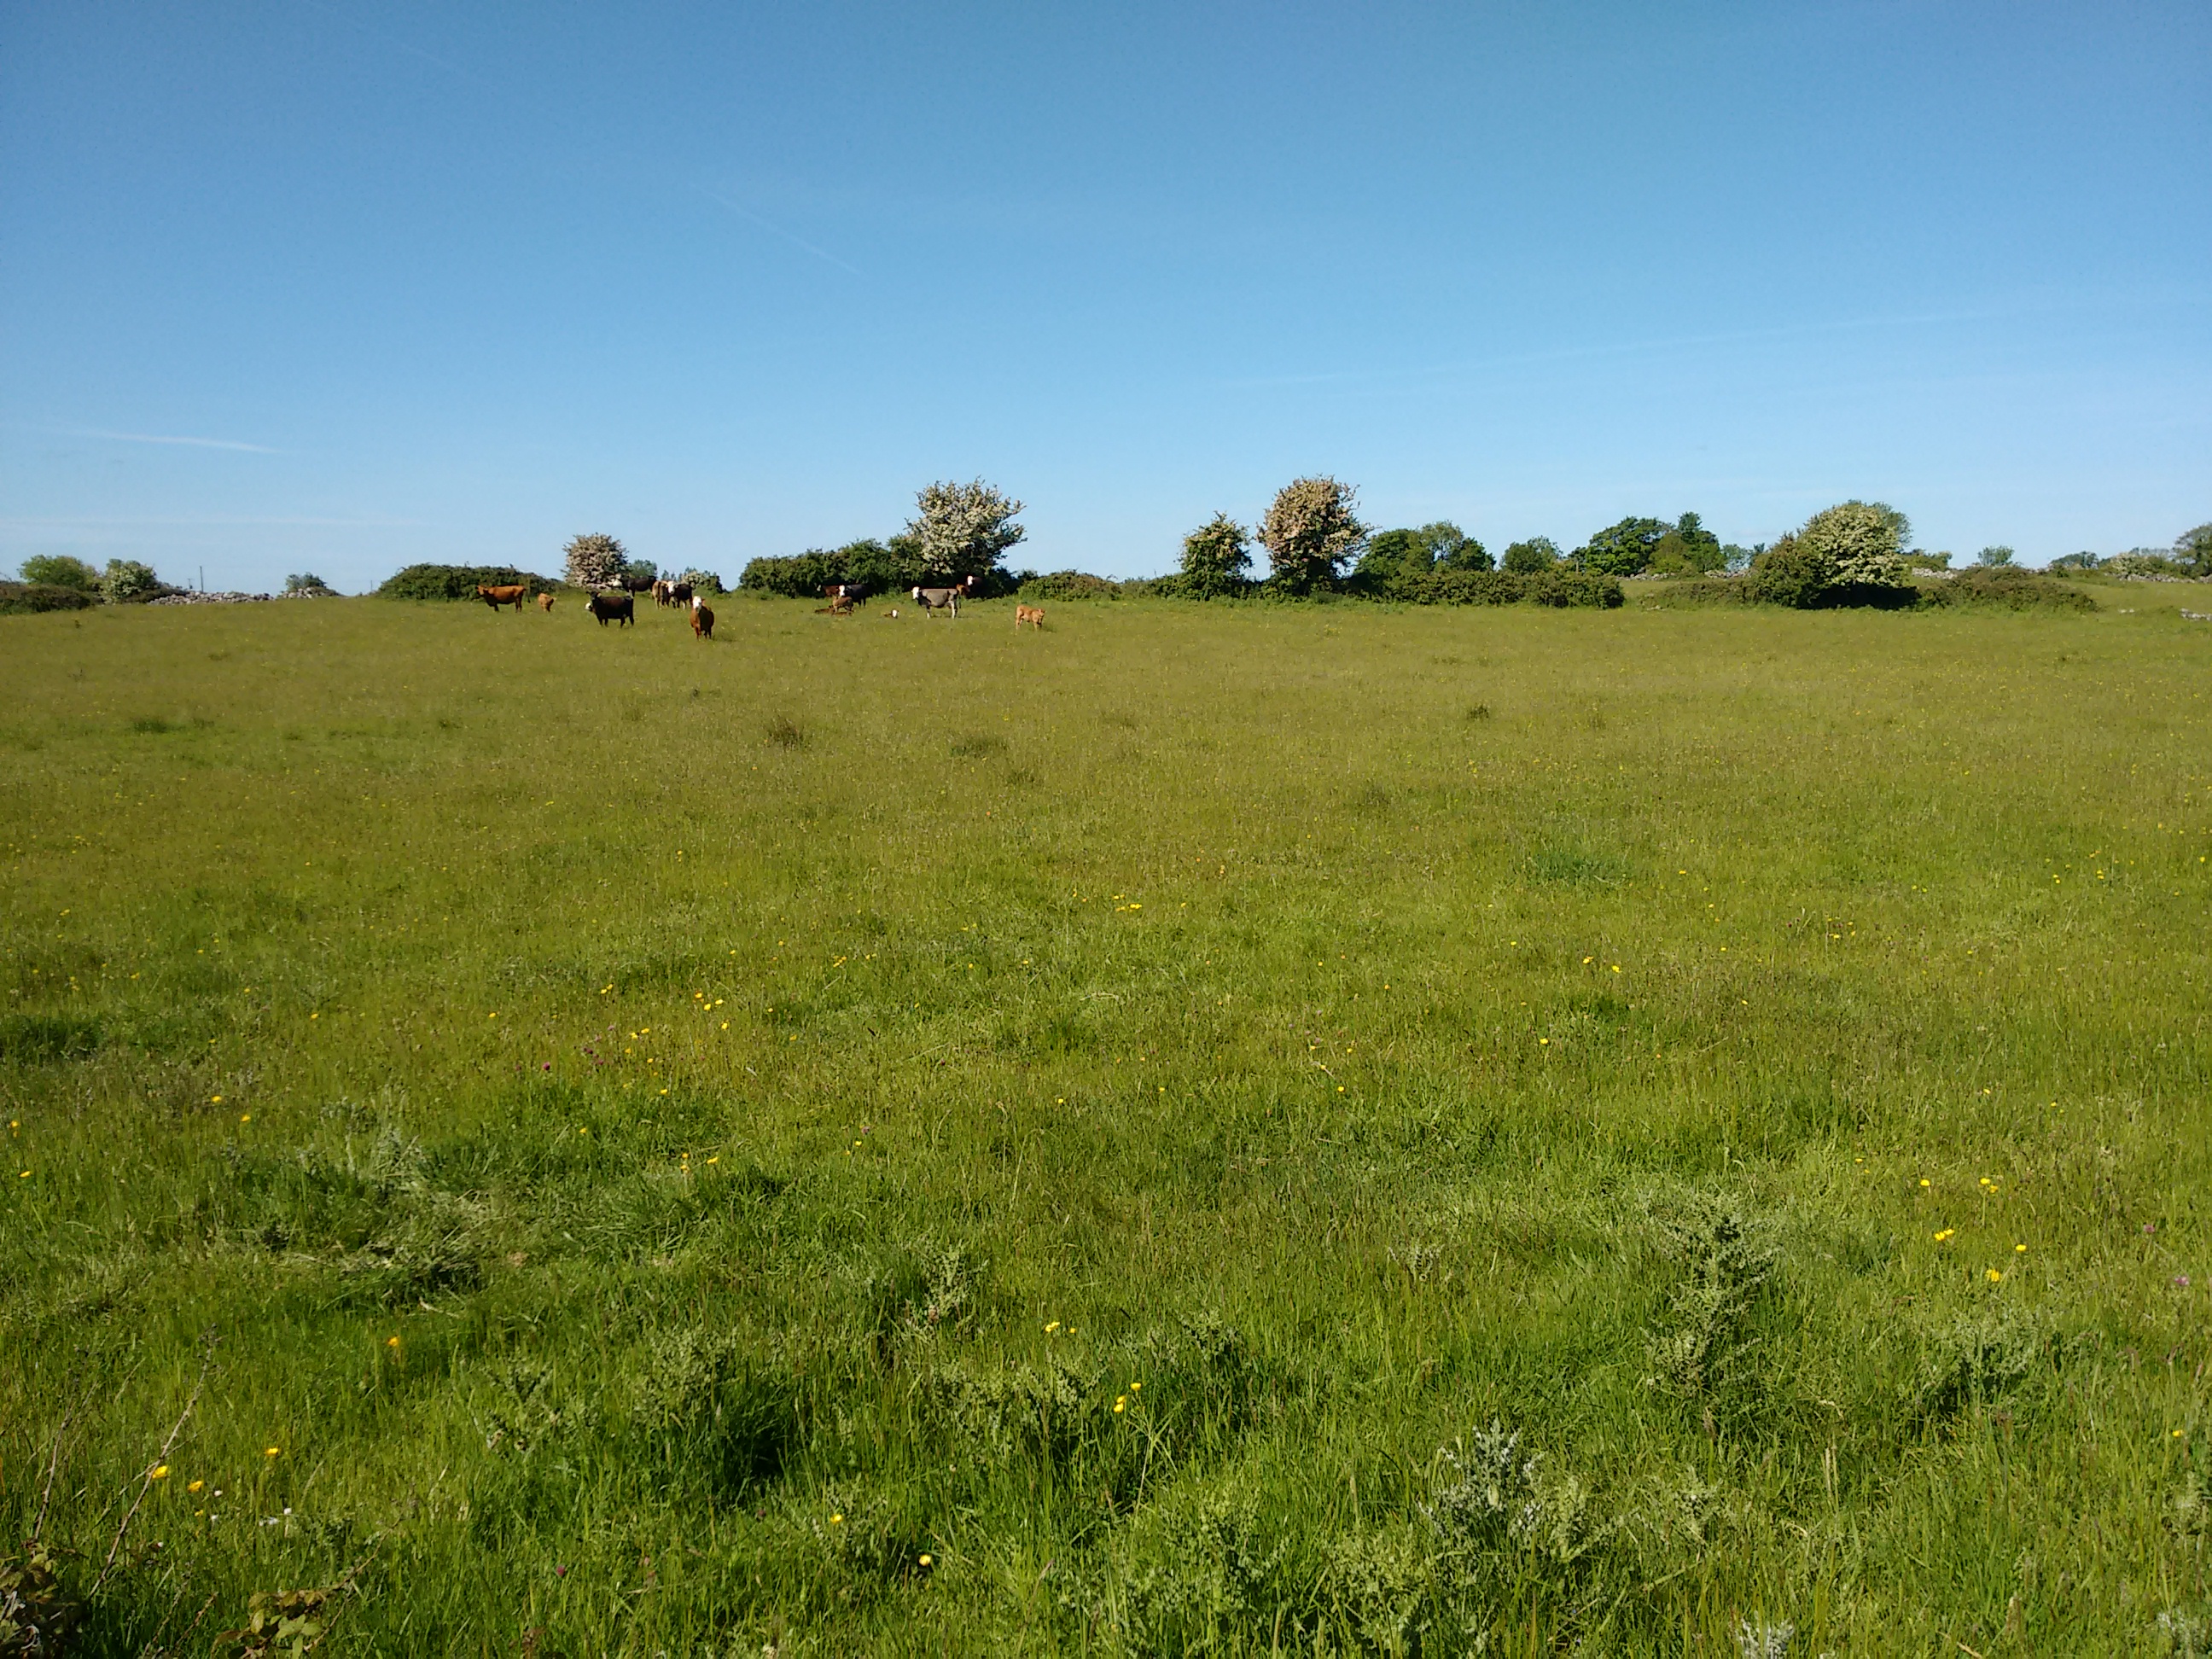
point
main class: Grassland
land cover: Grassland without tree/shrub cover
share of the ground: > 75 %
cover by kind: herbaceous plants 100 %
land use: Agriculture (excluding fallow land and kitchen gardens)
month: June
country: IE
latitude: 53.2167
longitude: -8.6026
